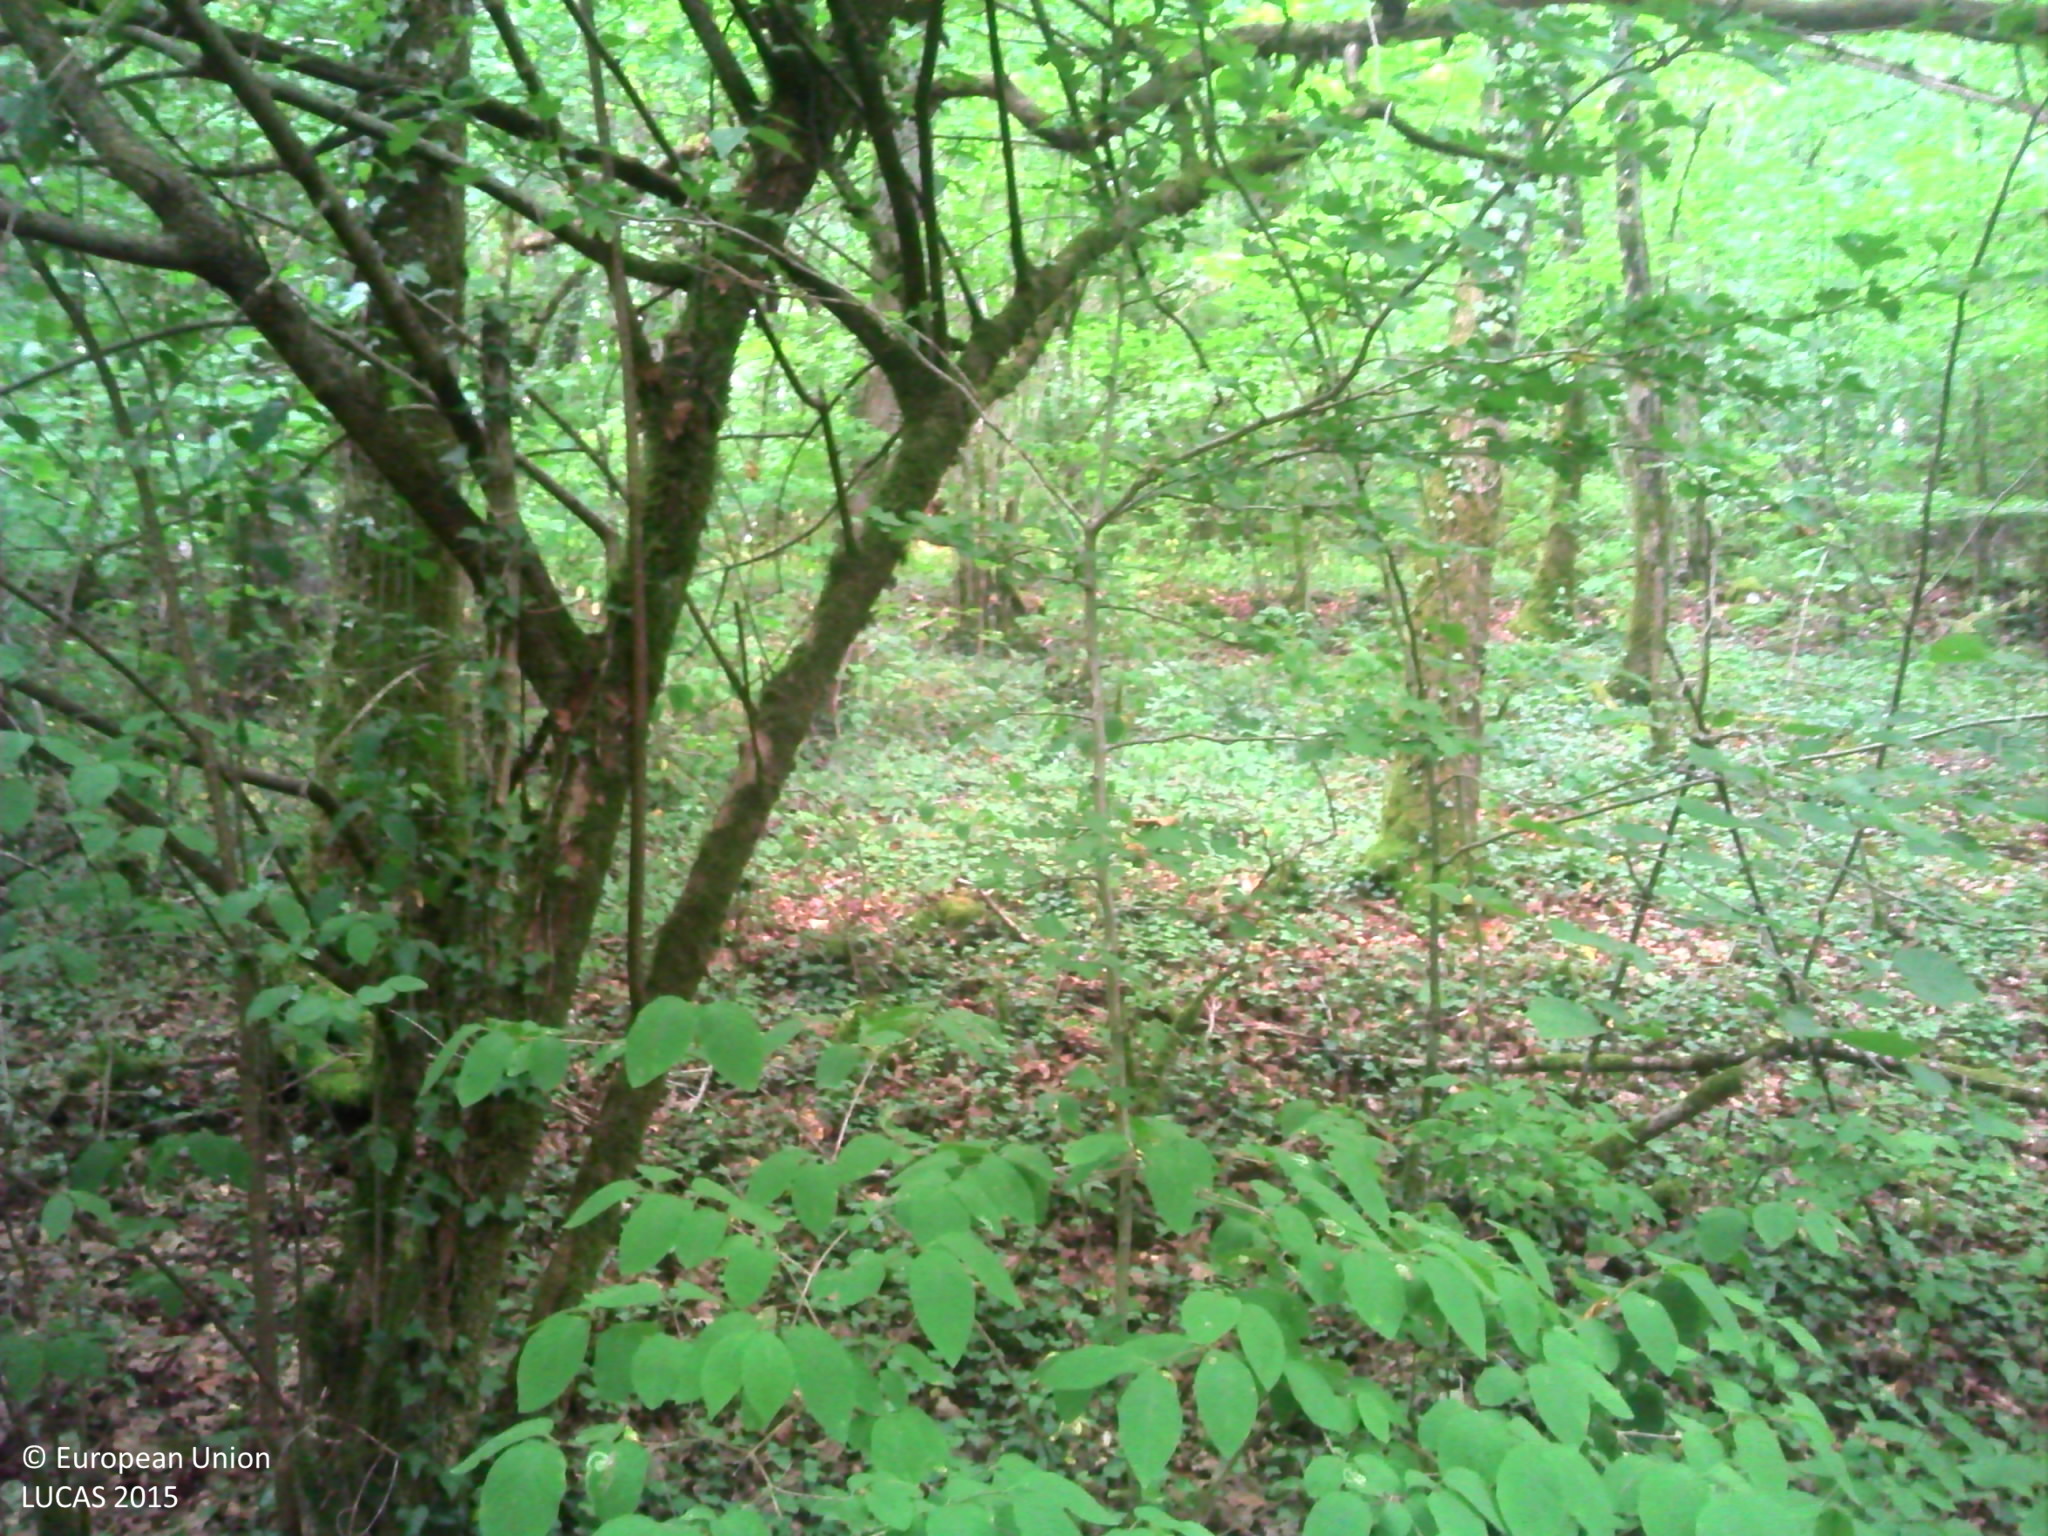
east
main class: Woodland
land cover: Broadleaved woodland
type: acidophilous oak and oak-birch forest
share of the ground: > 75 %
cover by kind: broadleaved forest trees 80 %, herbaceous plants 10 %, coniferous forest trees 5 %, lichens and mosses 5 %
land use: Forestry
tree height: > 5 m
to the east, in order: Broadleaved woodland; Fences; Grassland without tree/shrub cover; Single bushes/trees; Grassland without tree/shrub cover
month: July
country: FR
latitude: 48.0450
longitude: 5.1568
